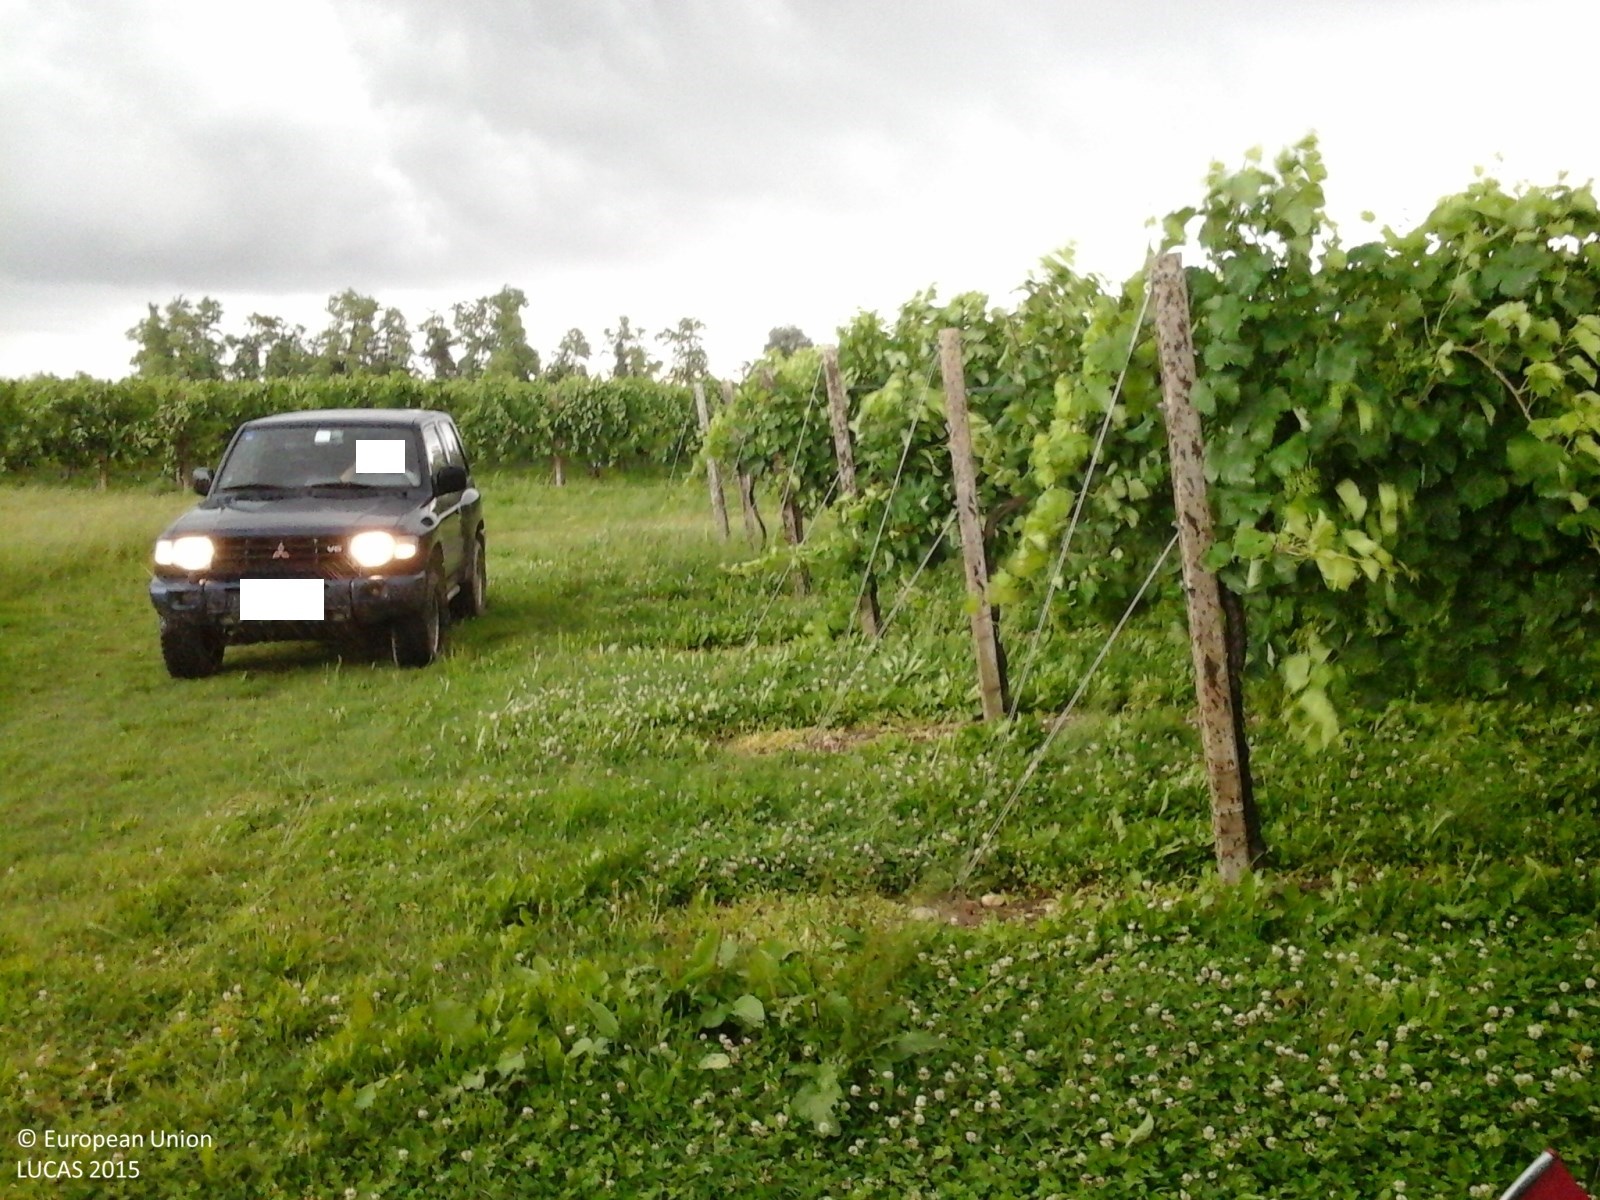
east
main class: Cropland
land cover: Vineyards
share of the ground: < 10 %
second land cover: Grassland without tree/shrub cover
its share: > 75 %
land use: Agriculture (excluding fallow land and kitchen gardens)
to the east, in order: Vineyards; Grassland without tree/shrub cover; Tracks; Ditches and canals; Vineyards; Tracks; Vineyards; Tracks; Grass margins; Abandoned hedges; Maize
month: June
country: IT
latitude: 45.8393
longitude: 12.3272
